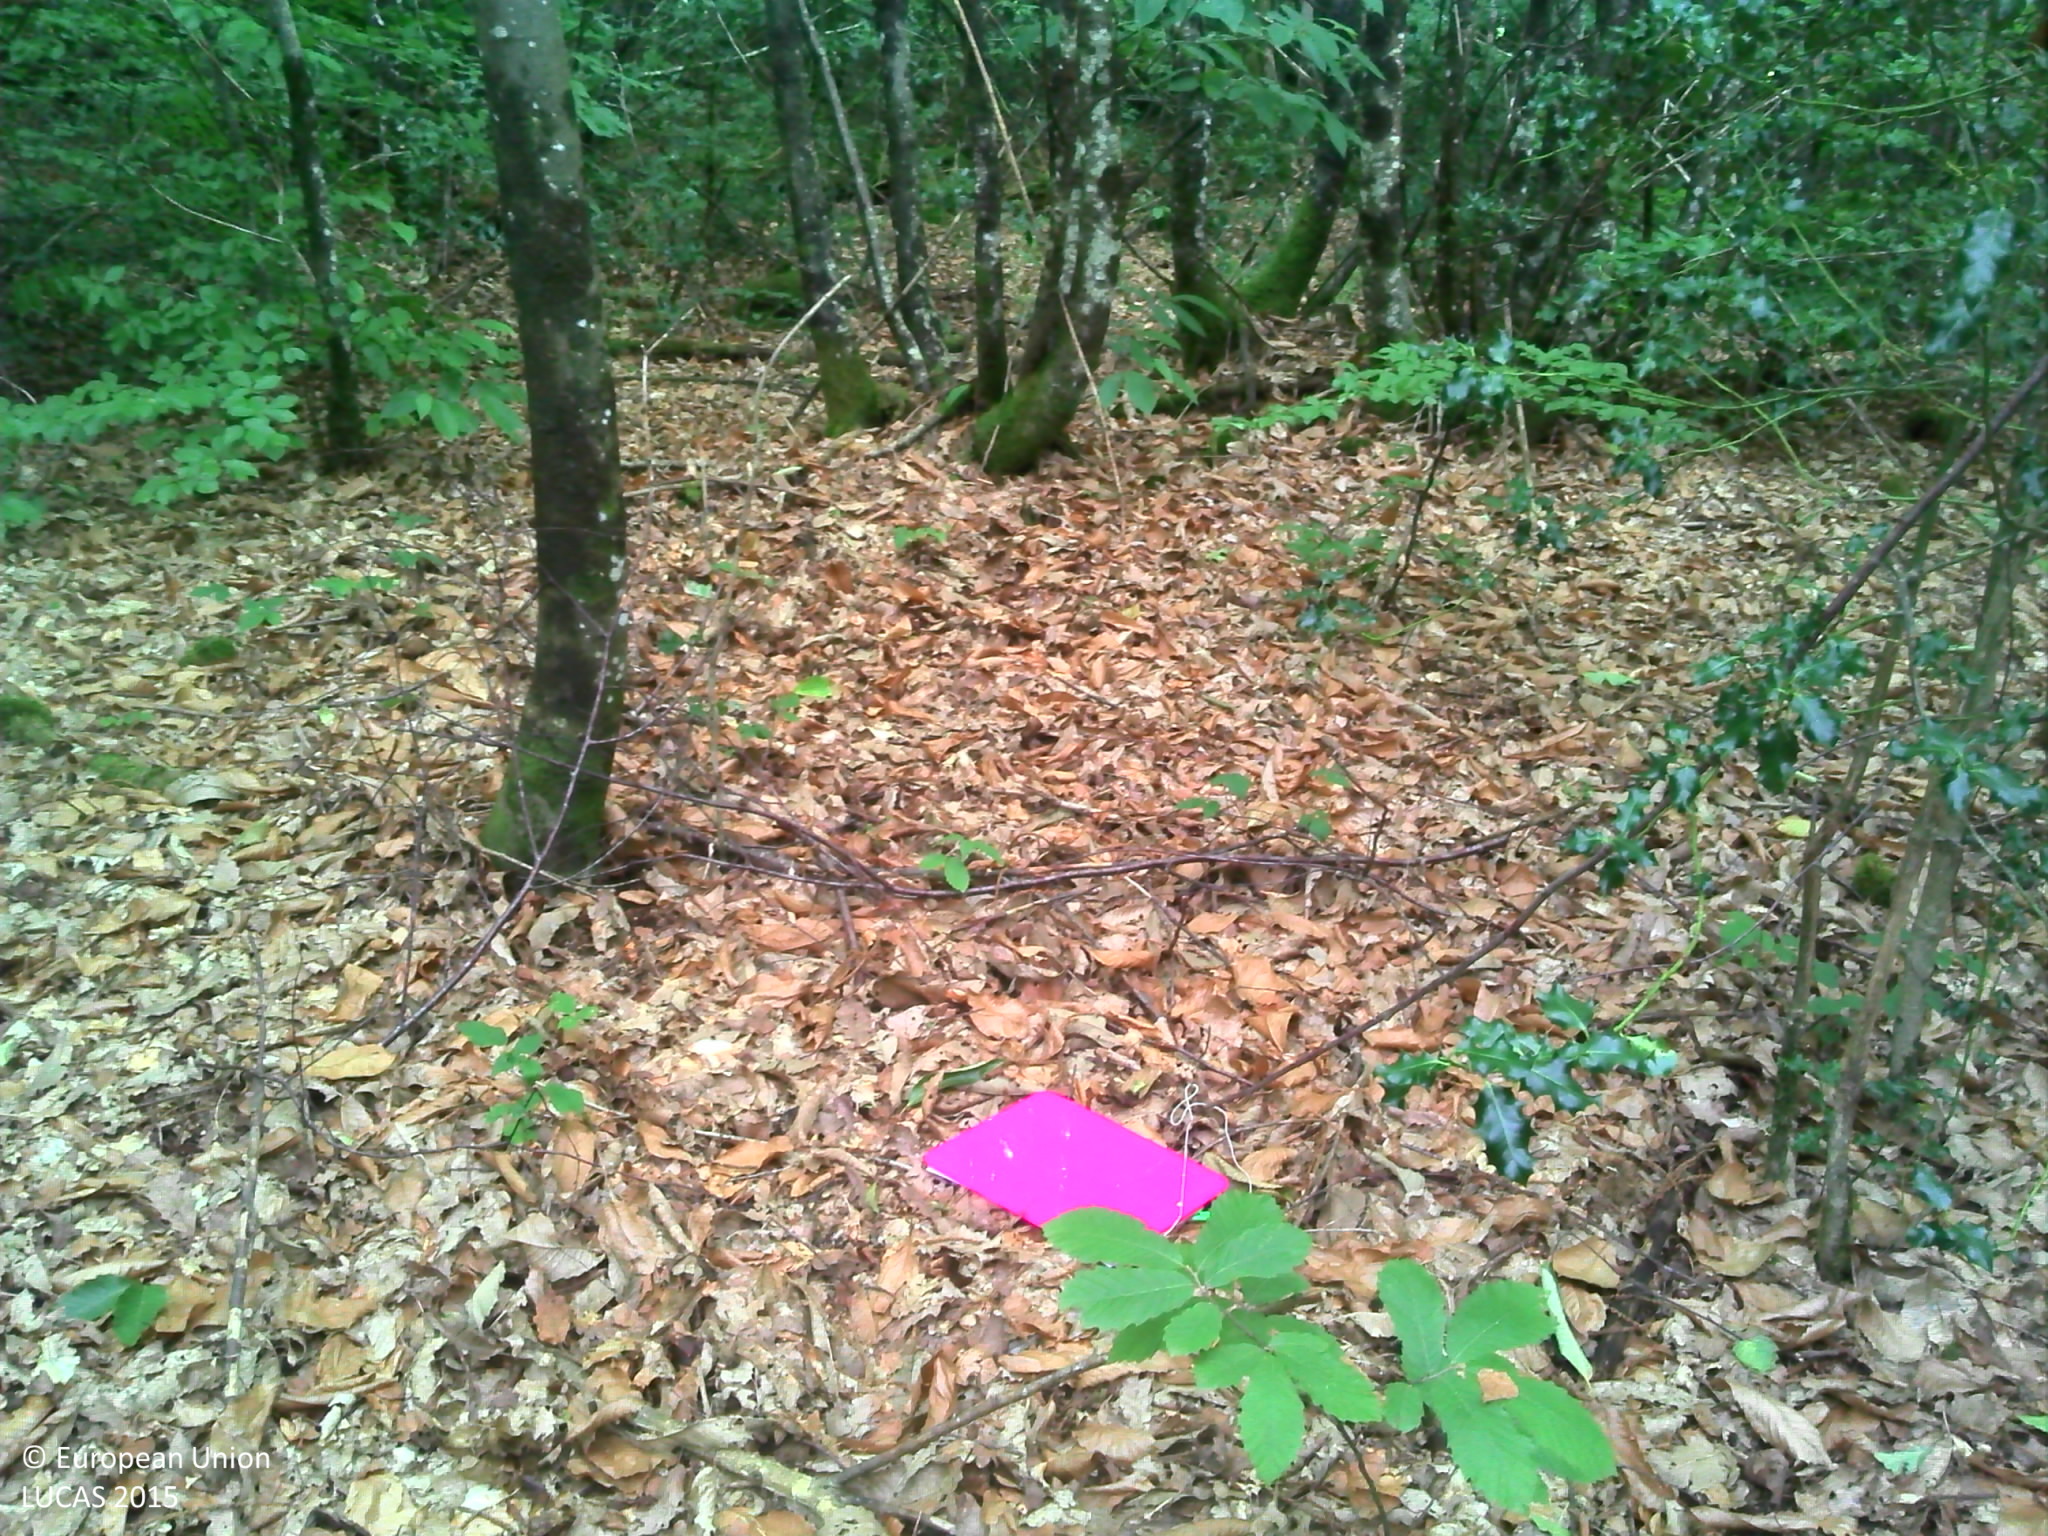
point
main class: Woodland
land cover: Broadleaved woodland
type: acidophilous oak and oak-birch forest
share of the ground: > 75 %
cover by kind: broadleaved forest trees 100 %
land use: Semi-natural and natural areas not in use
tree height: > 5 m
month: August
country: FR
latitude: 45.8938
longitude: 1.6027
